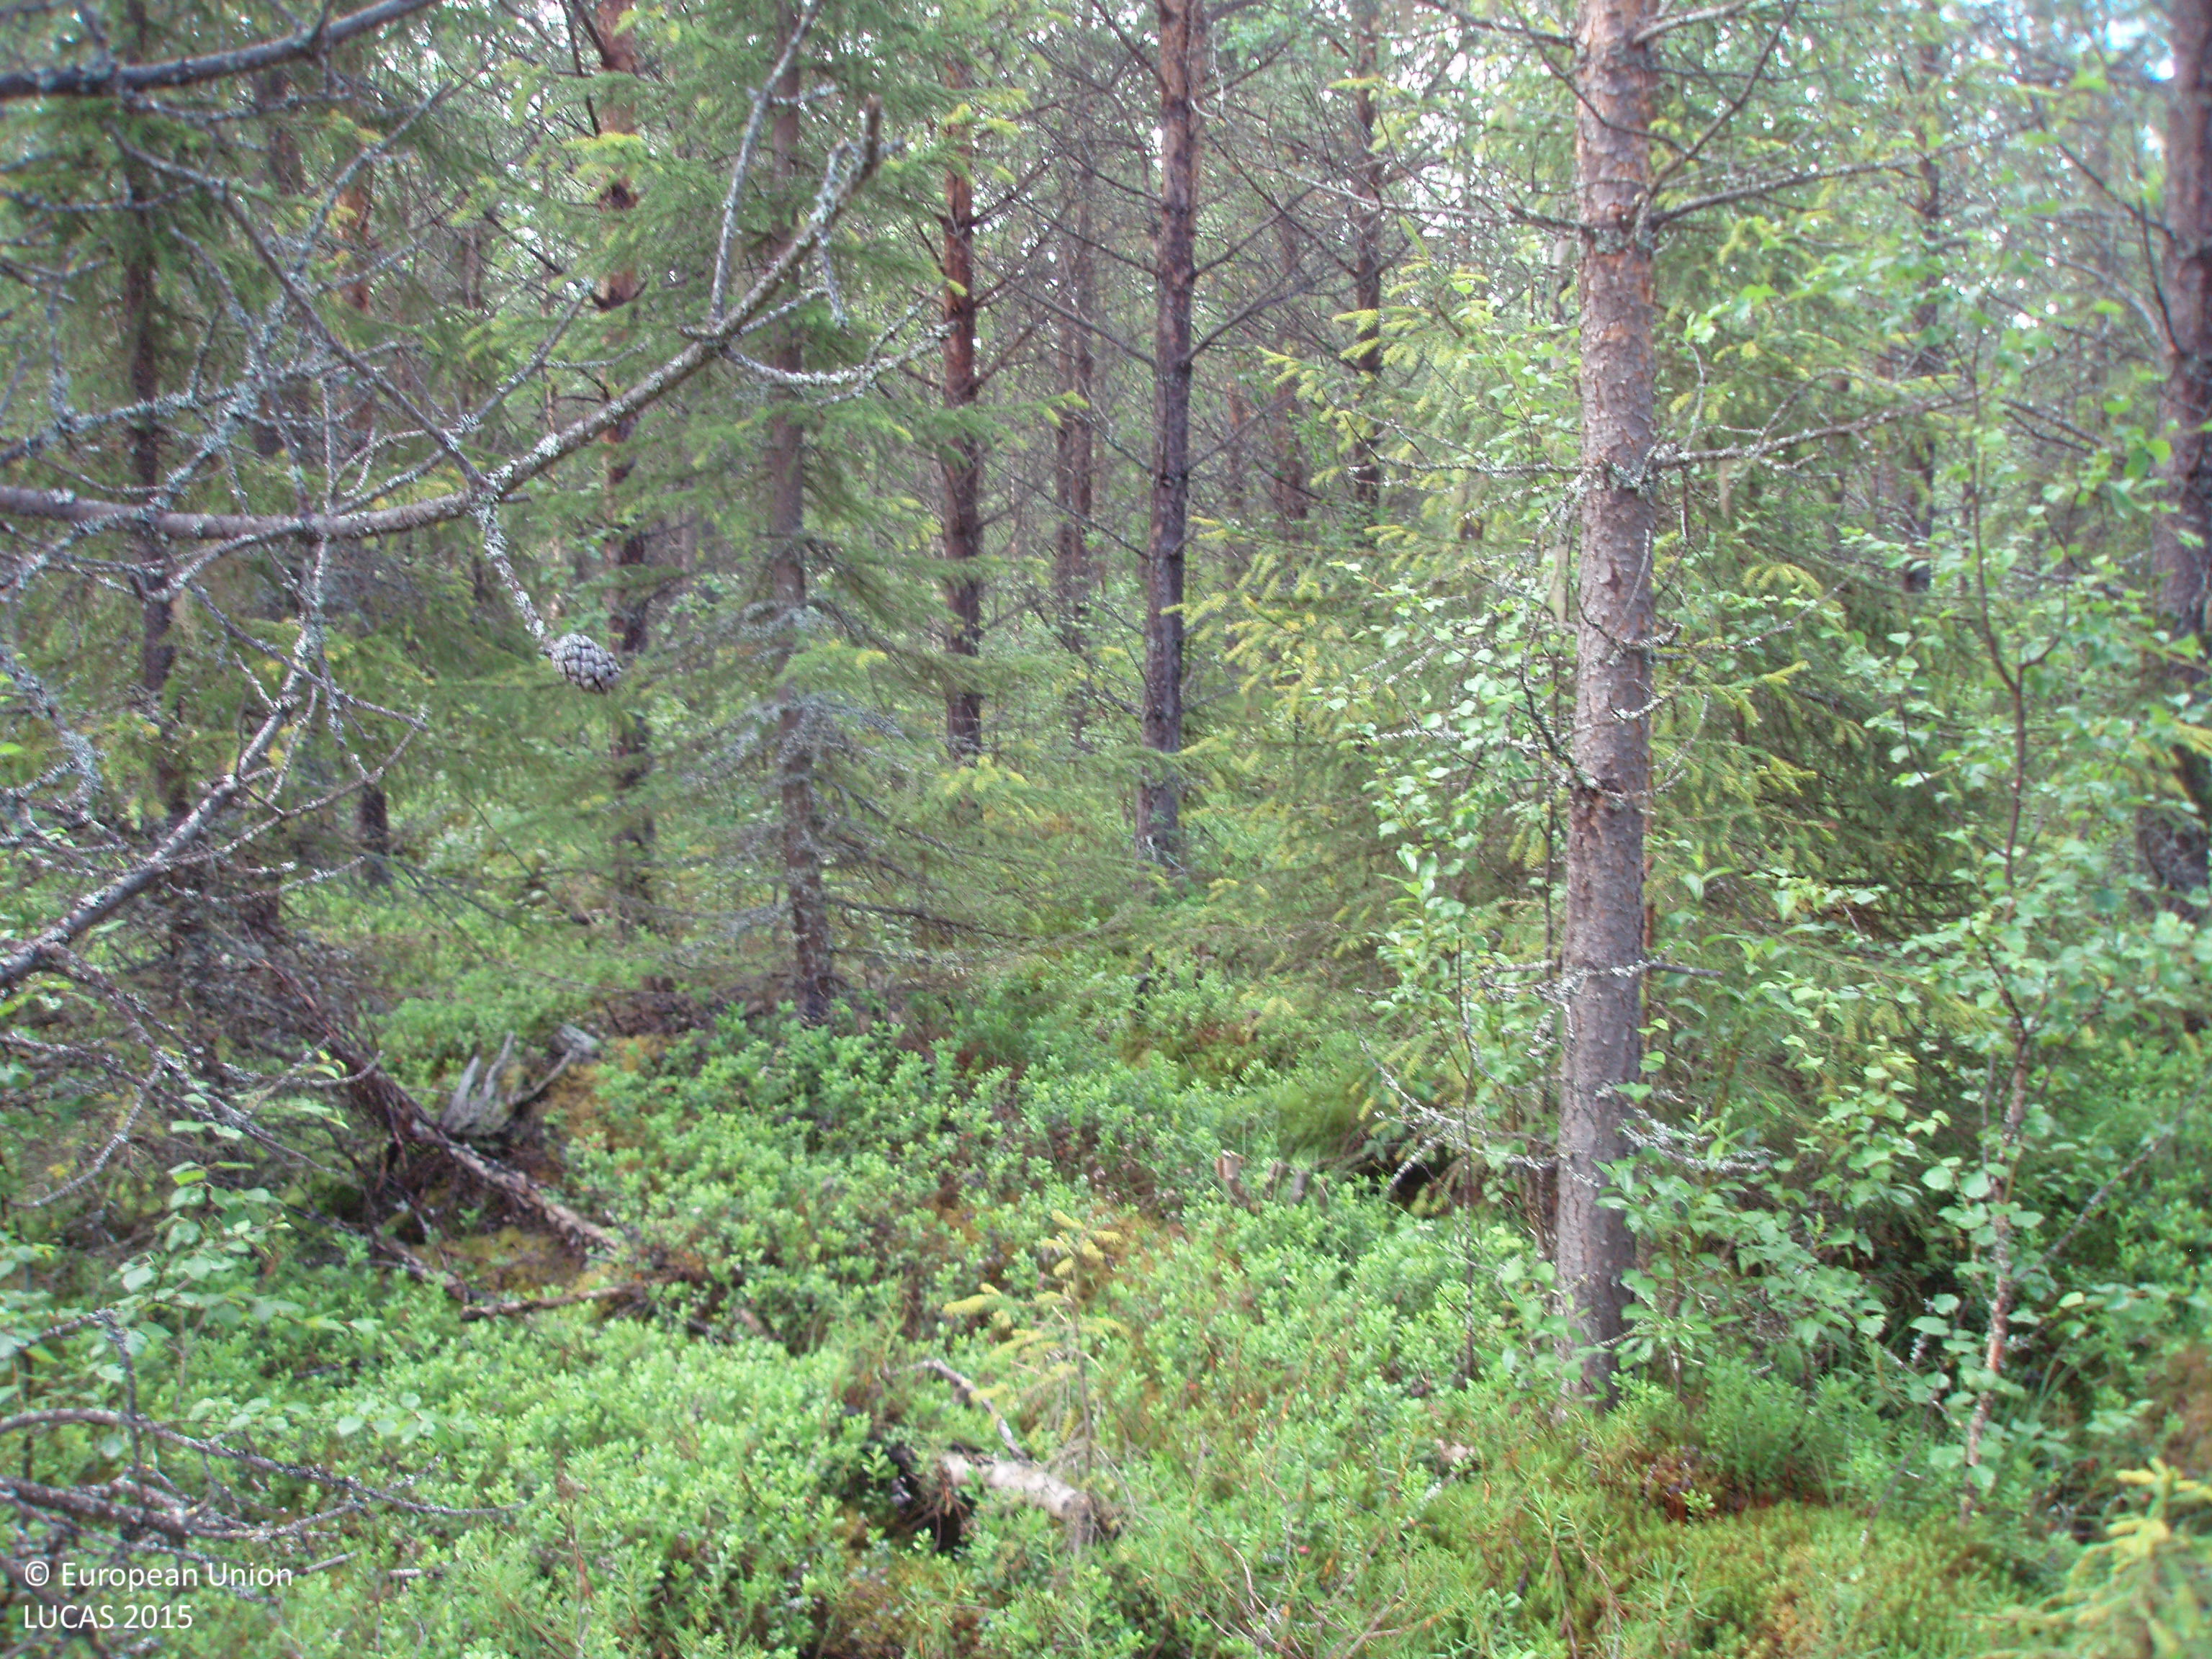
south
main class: Woodland
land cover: Other mixed woodland
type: boreal forest
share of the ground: > 75 %
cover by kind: coniferous forest trees 60 %, broadleaved forest trees 25 %, shrubs 15 %
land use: Forestry
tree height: > 5 m
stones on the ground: < 10 %
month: July
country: FI
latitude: 66.9242
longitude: 27.9781
